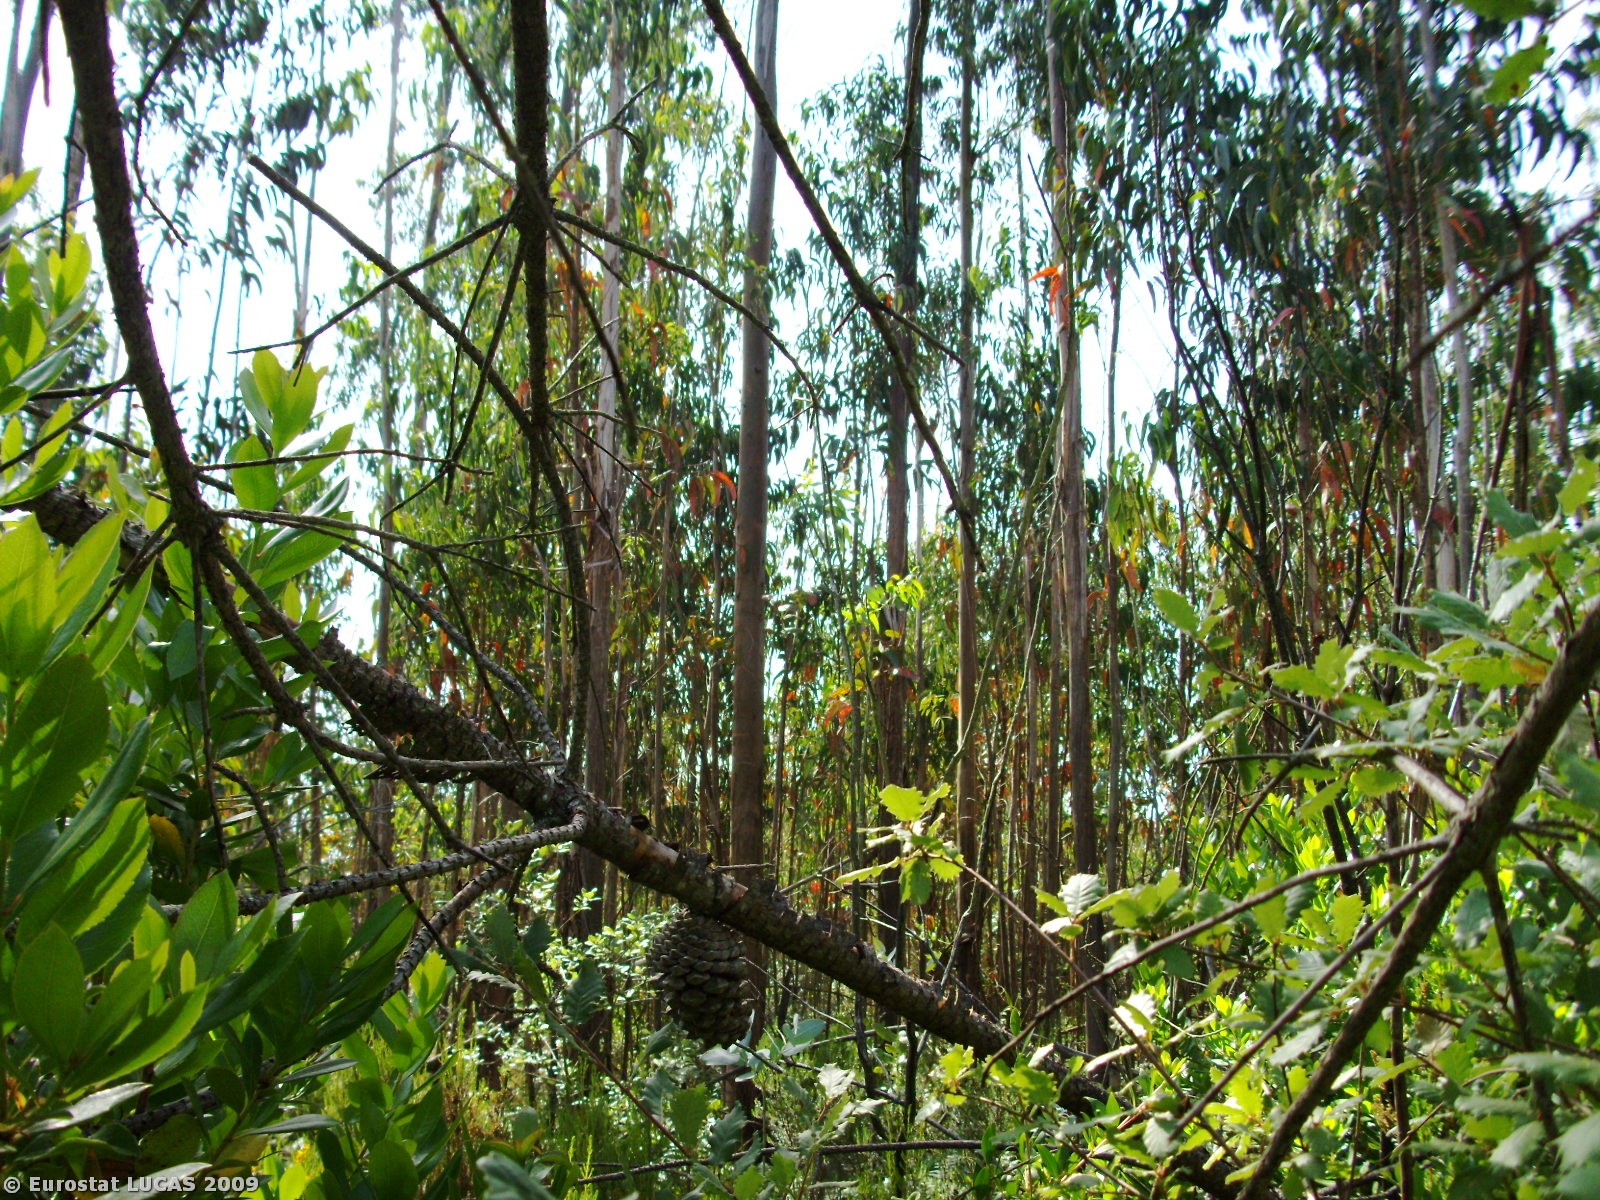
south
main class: Woodland
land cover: Broadleaved woodland
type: plantations and self-sown exotic forest
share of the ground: 50 - 75 %
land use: Forestry
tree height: > 5 m
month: June
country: PT
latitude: 39.9709
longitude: -8.4984
